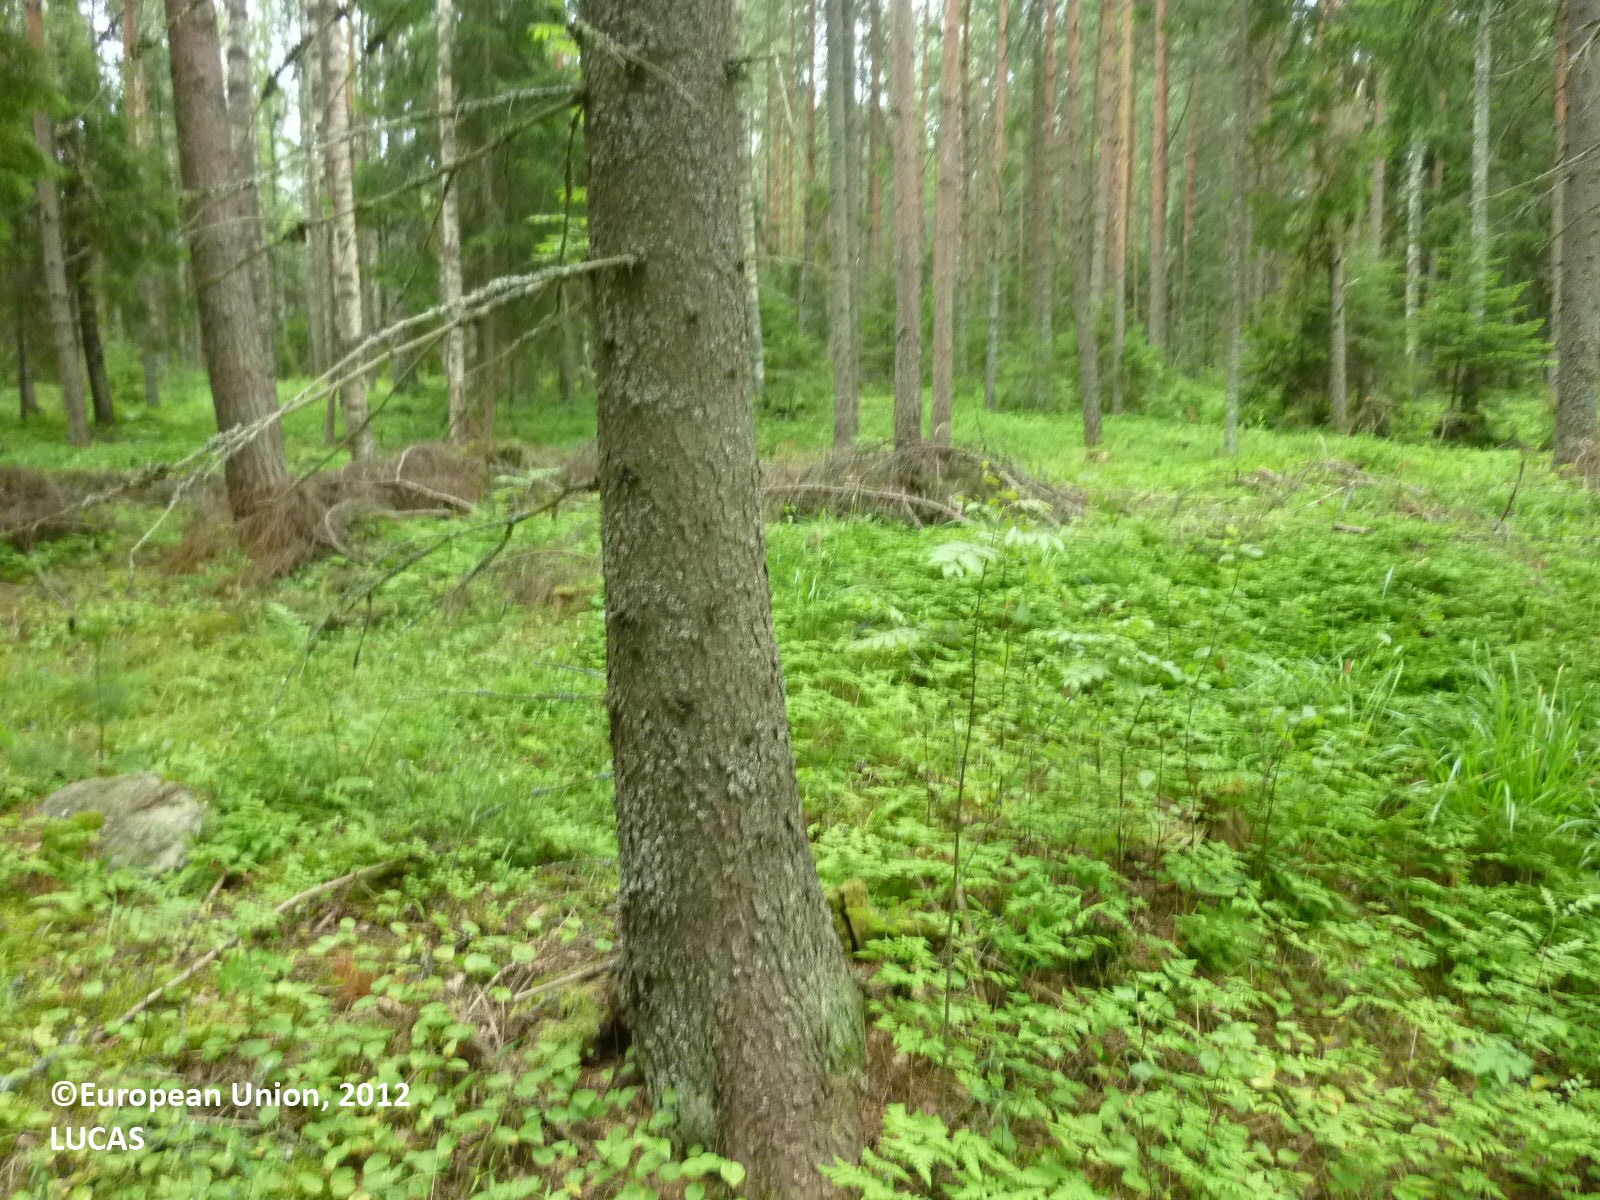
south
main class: Woodland
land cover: Spruce dominated coniferous woodland
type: boreal forest
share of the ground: > 75 %
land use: Forestry
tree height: > 5 m
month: July
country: FI
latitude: 61.3064
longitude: 22.0263
